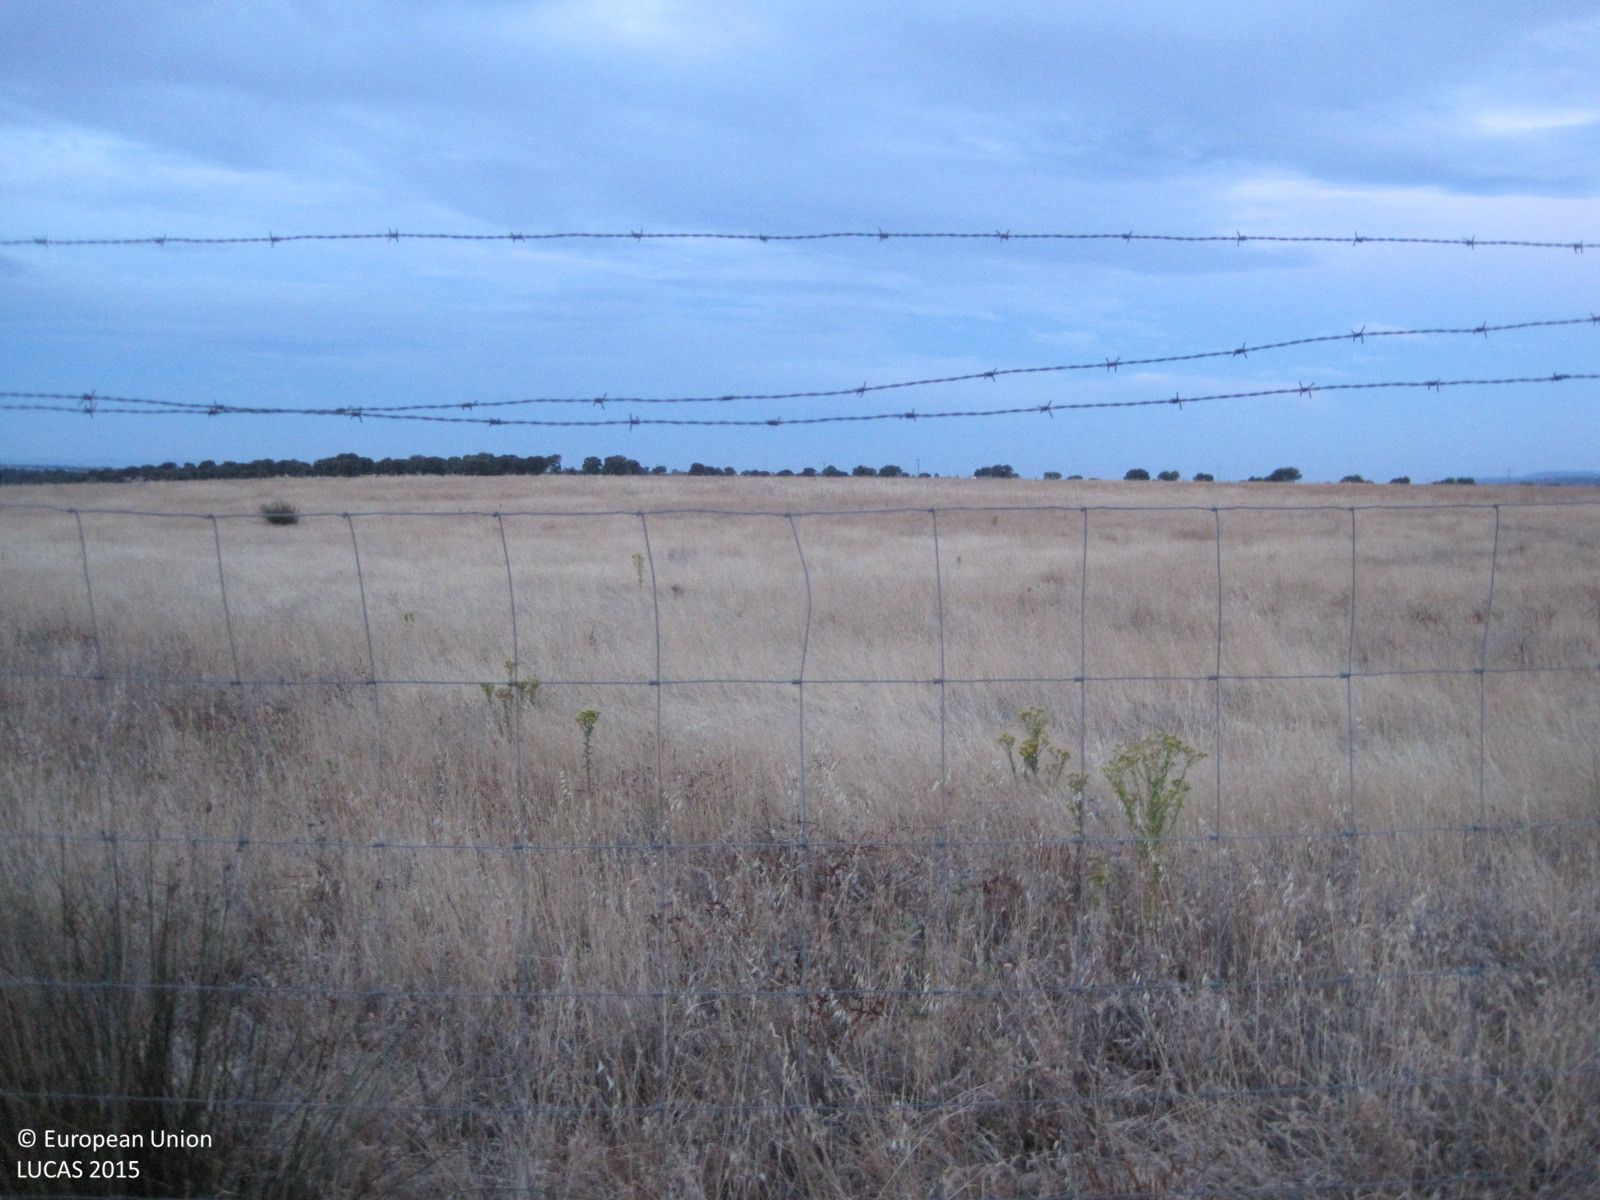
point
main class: Grassland
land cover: Spontaneously vegetated surfaces
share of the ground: > 75 %
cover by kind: herbaceous plants 100 %
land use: Agriculture (excluding fallow land and kitchen gardens)
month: July
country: ES
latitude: 40.1914
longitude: -4.3862
